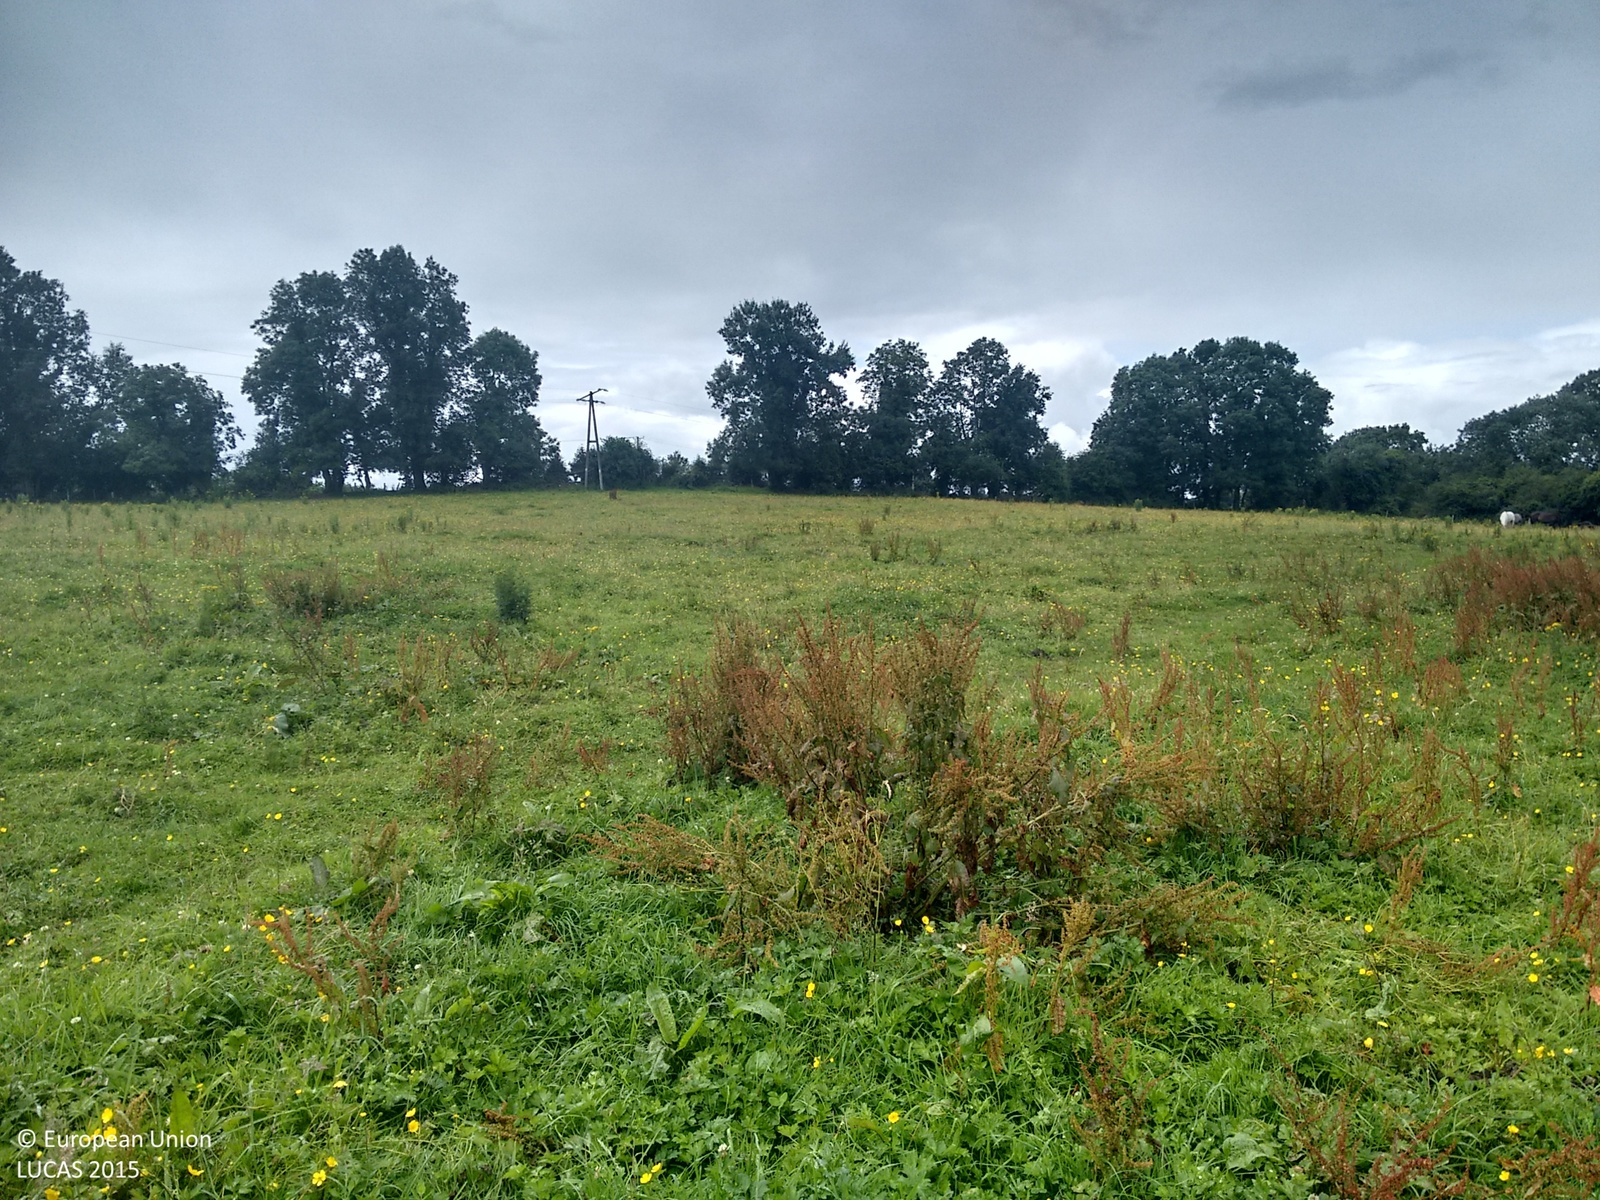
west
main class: Grassland
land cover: Grassland without tree/shrub cover
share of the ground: > 75 %
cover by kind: herbaceous plants 100 %
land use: Agriculture (excluding fallow land and kitchen gardens)
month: July
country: IE
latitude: 53.7454
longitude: -7.8026
